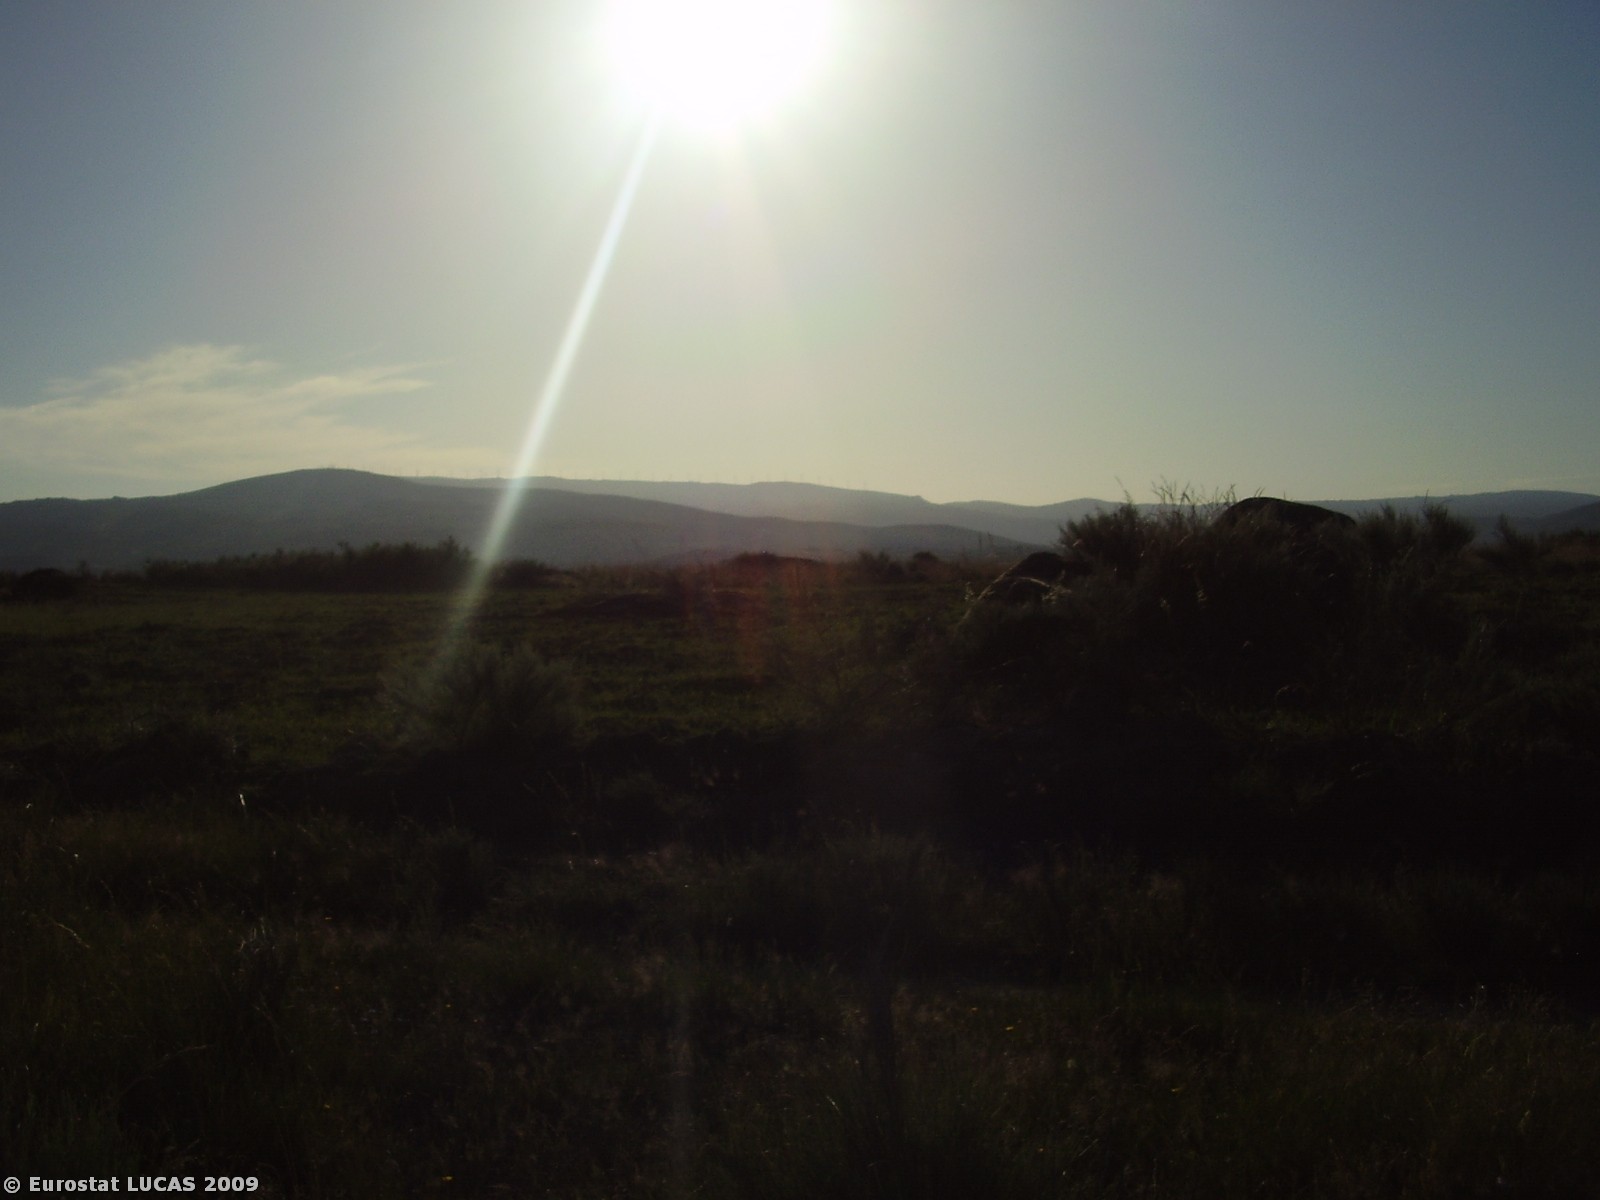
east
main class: Grassland
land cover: Spontaneously vegetated surfaces
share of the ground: > 75 %
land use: Nature reserves
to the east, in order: Spontaneously vegetated surfaces; Tracks; Rye; Spontaneously vegetated surfaces; Rock outcrops; Spontaneously vegetated surfaces; Rock outcrops; Spontaneously vegetated surfaces; Shrubland without tree cover
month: June
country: PT
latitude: 41.9595
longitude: -7.0005
